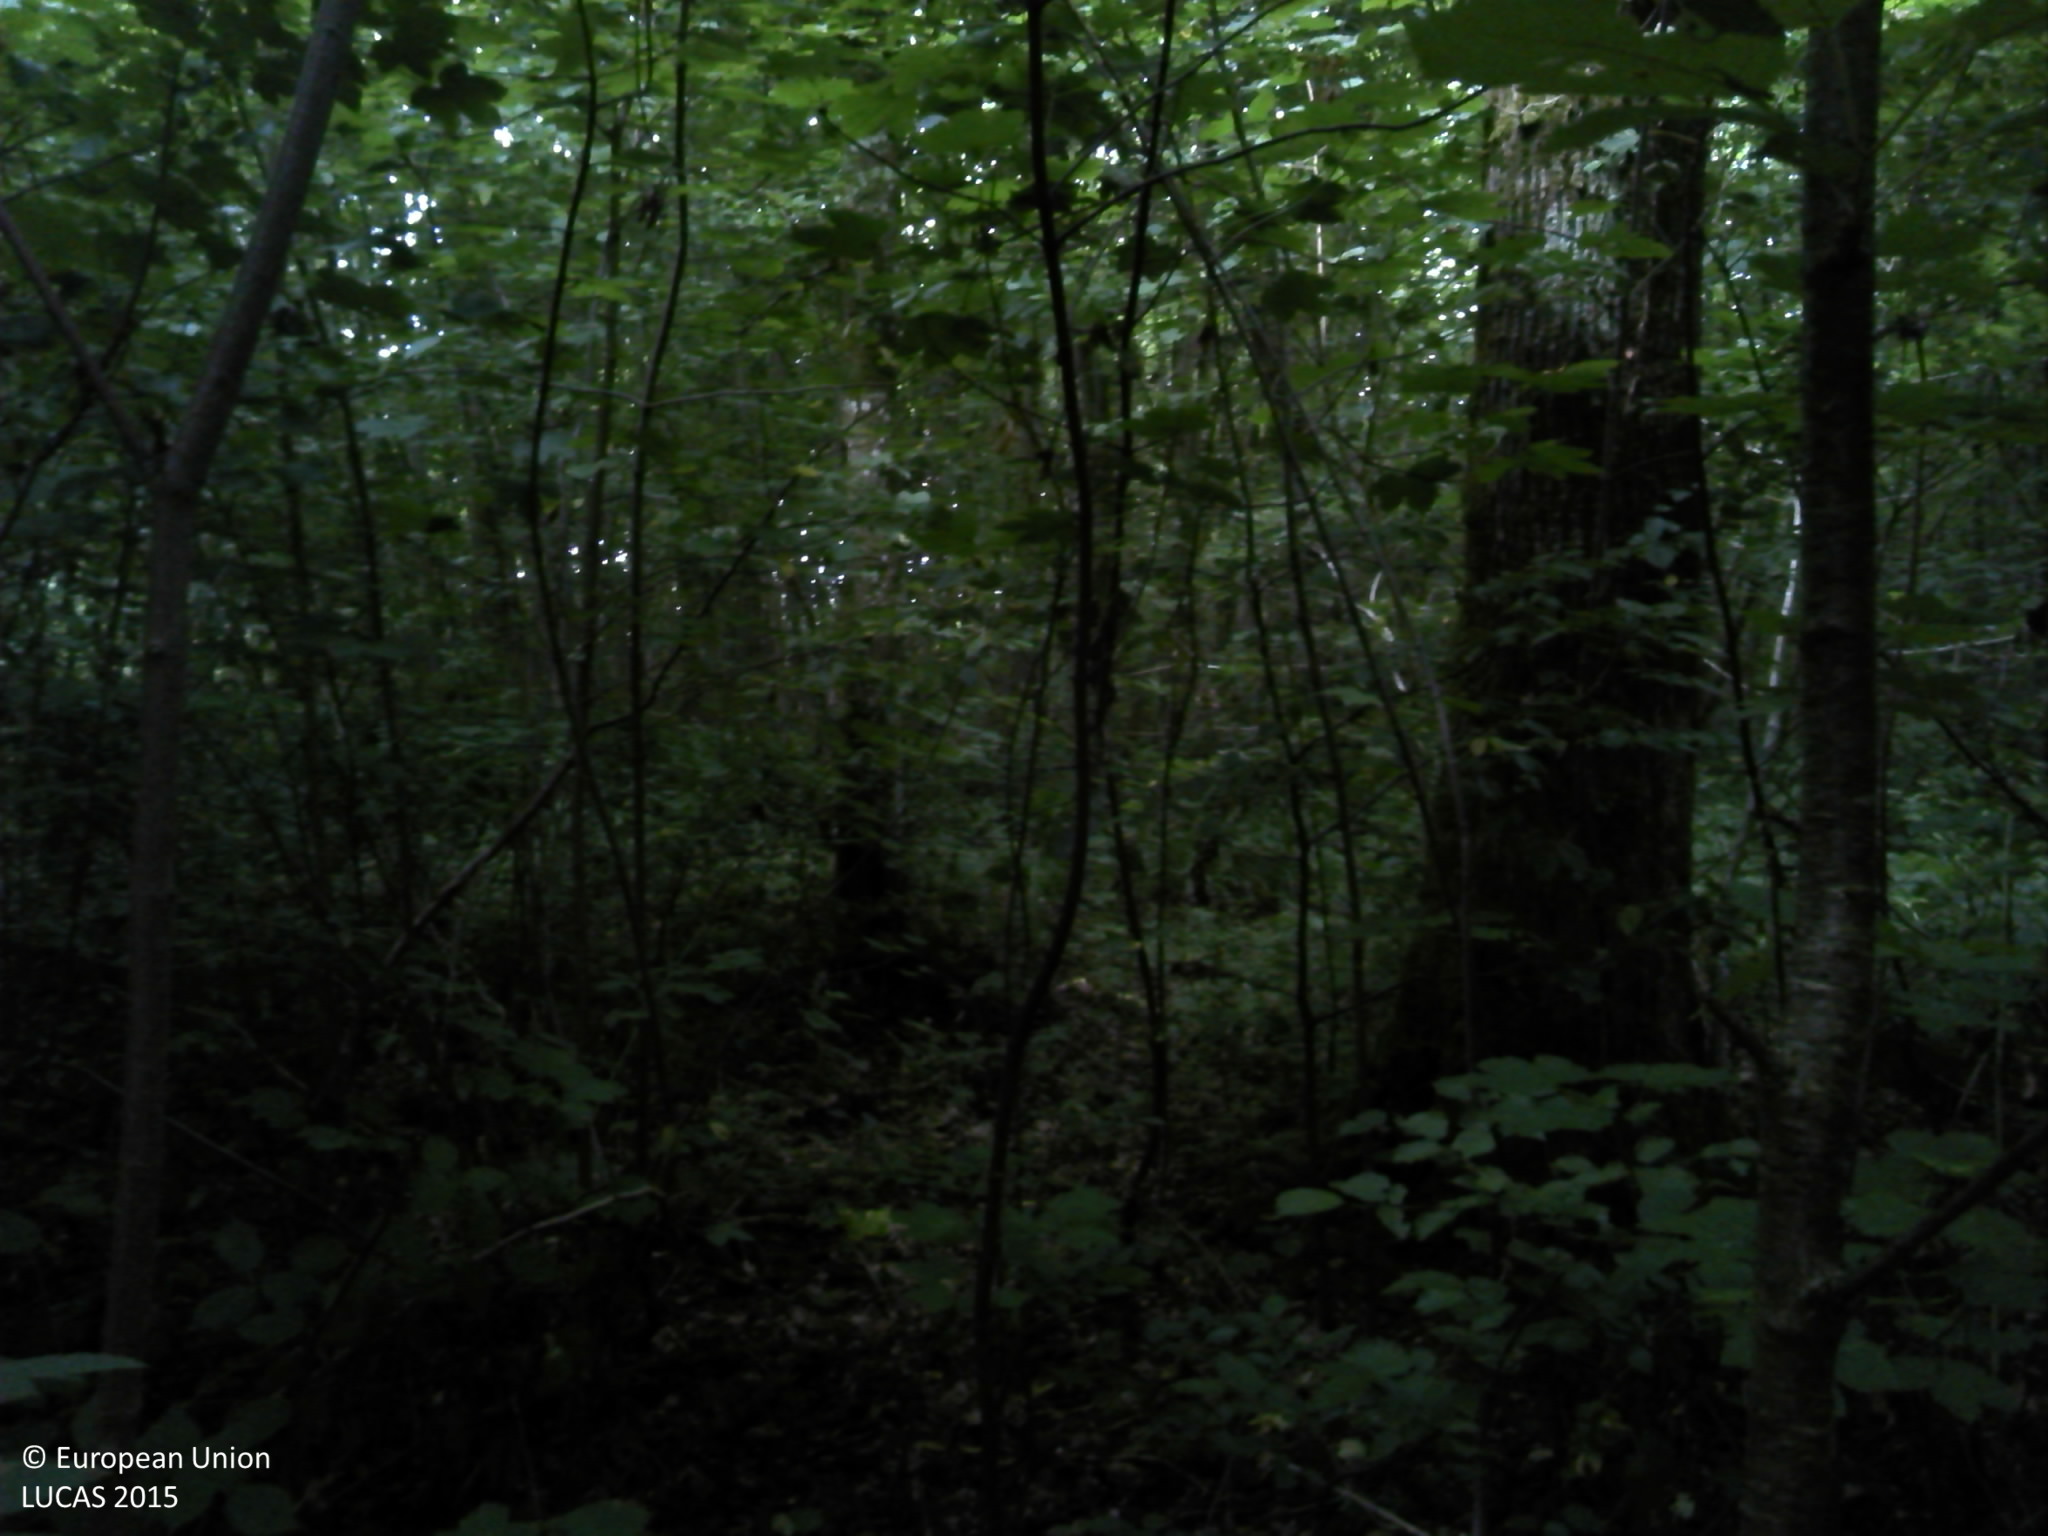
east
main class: Woodland
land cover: Broadleaved woodland
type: beech forest
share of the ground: > 75 %
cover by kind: broadleaved forest trees 80 %, consolidated bare surface 15 %, herbaceous plants 5 %
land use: Forestry
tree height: > 5 m
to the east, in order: Broadleaved woodland
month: July
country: FR
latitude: 49.6728
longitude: 4.4949
